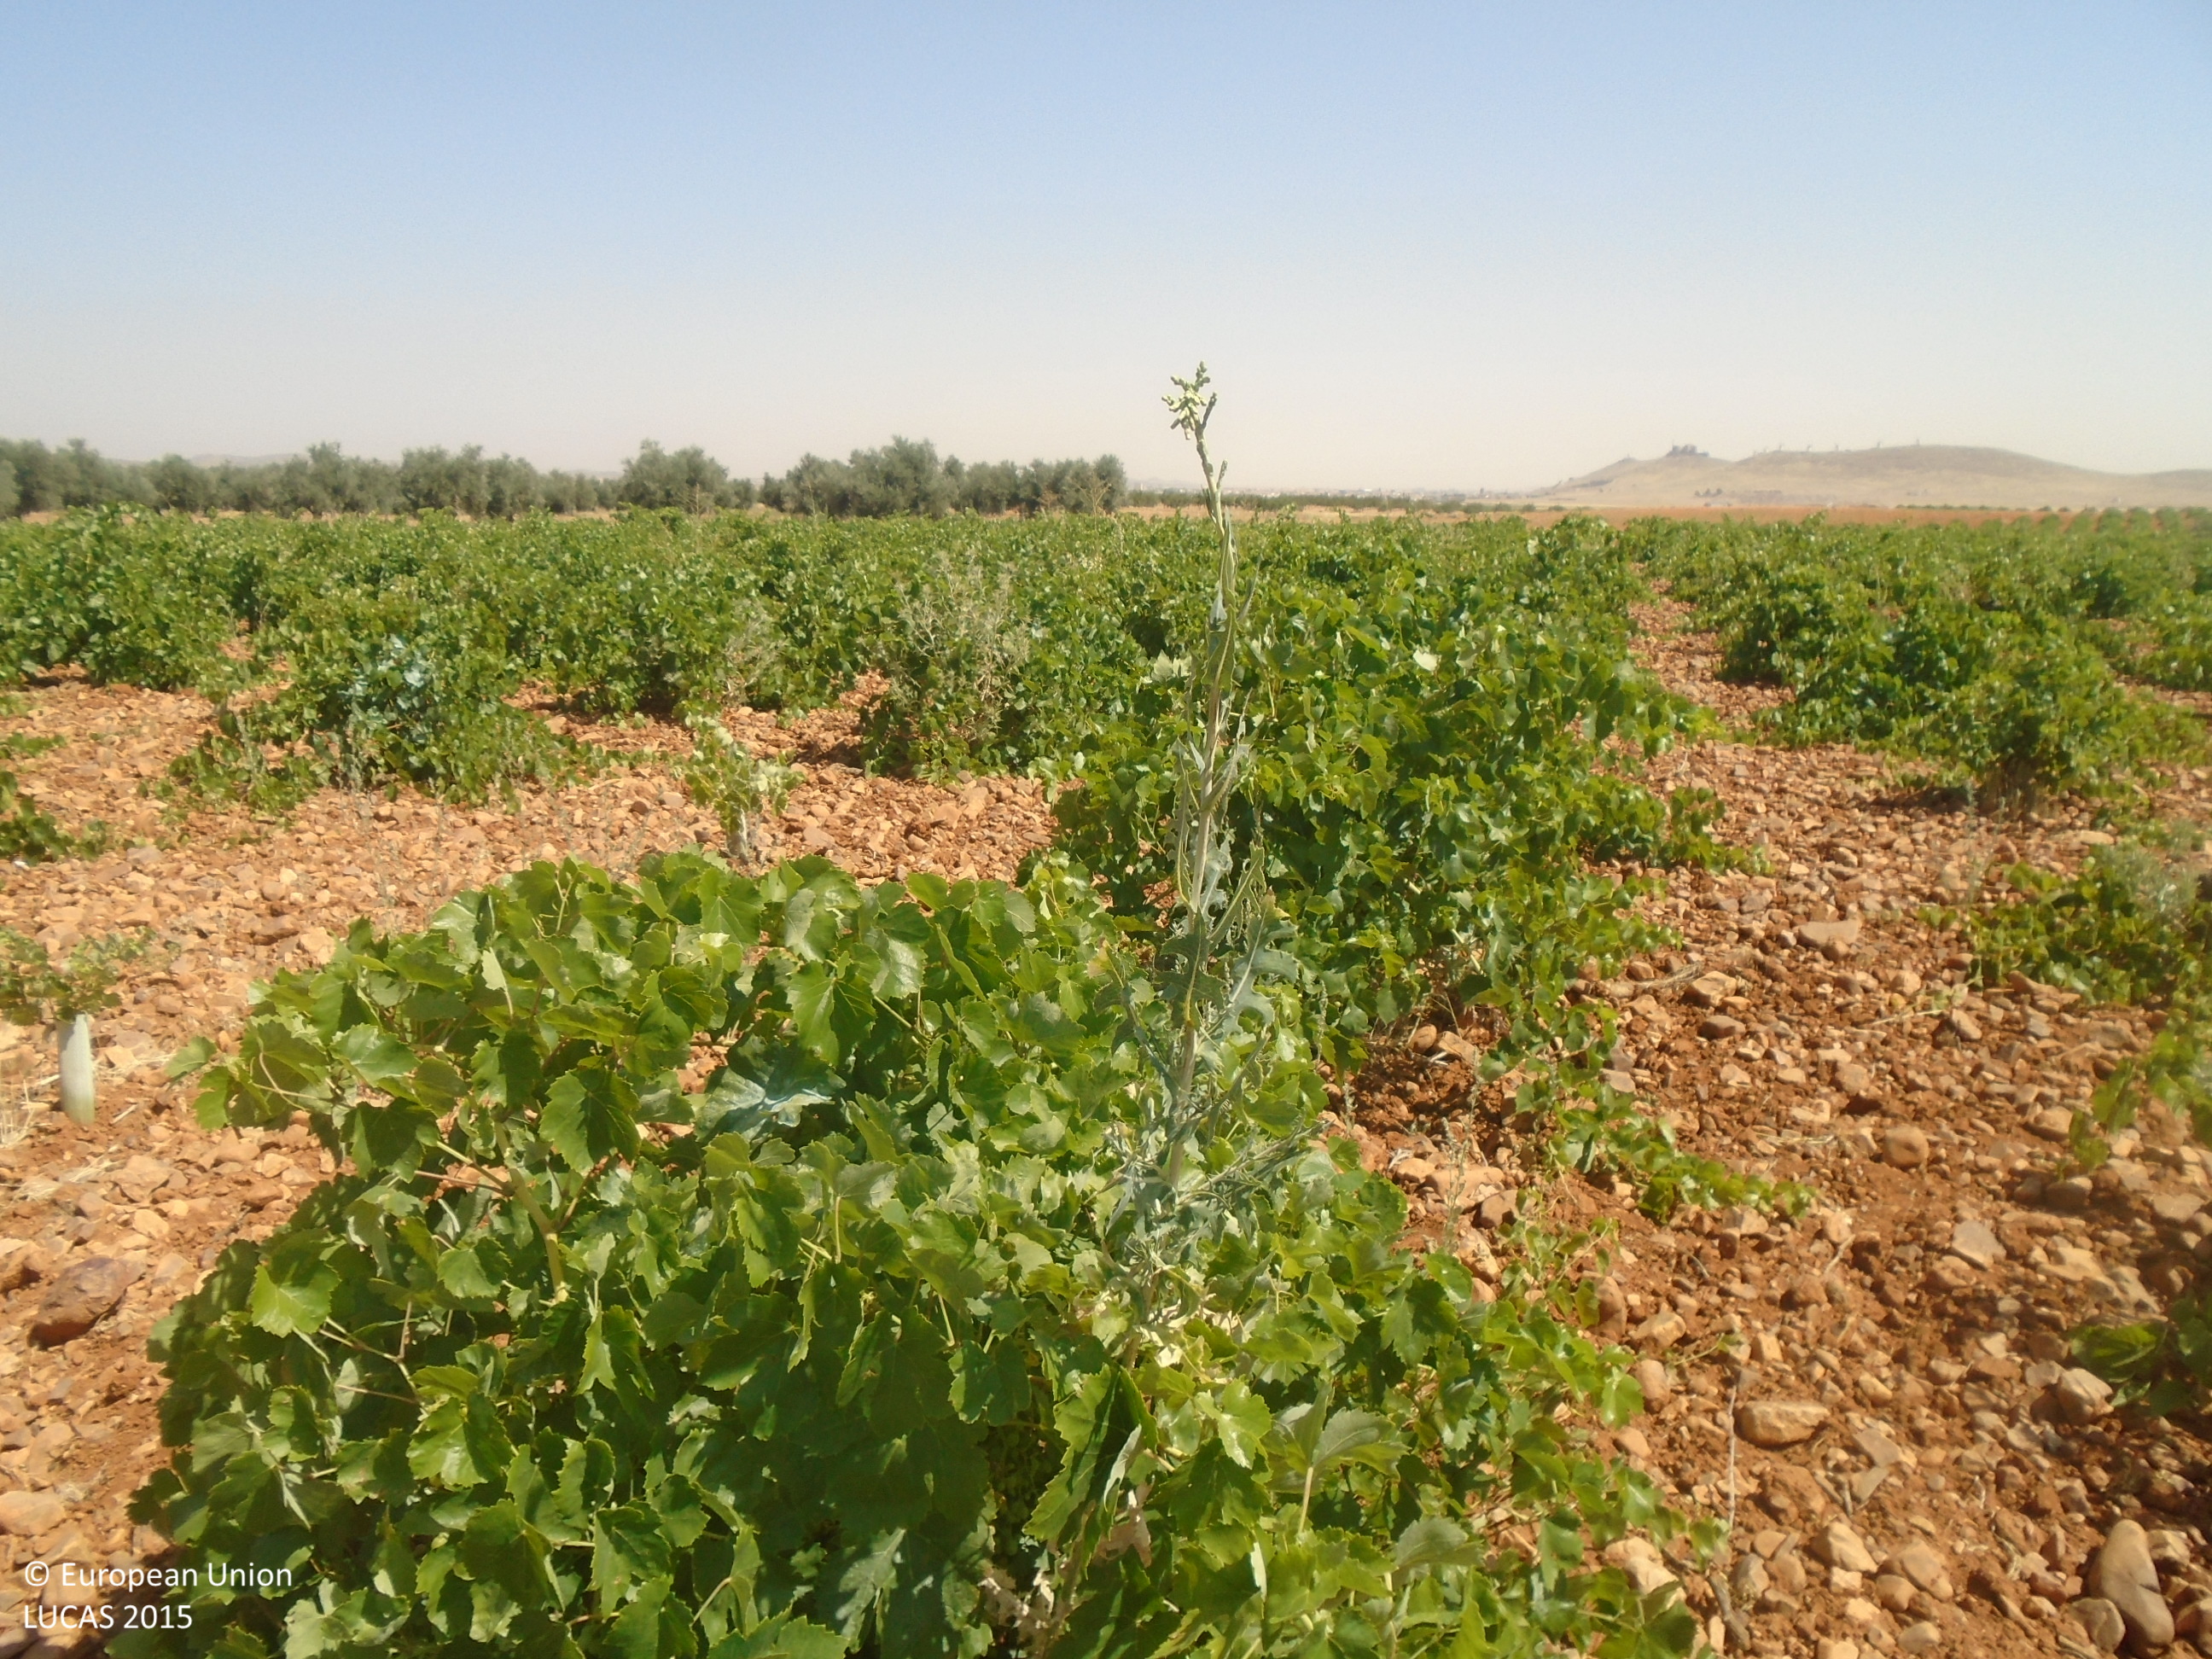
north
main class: Cropland
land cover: Vineyards
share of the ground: 10 - 25 %
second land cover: Other bare soil
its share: > 75 %
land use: Agriculture (excluding fallow land and kitchen gardens)
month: July
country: ES
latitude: 39.4218
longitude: -3.6254
